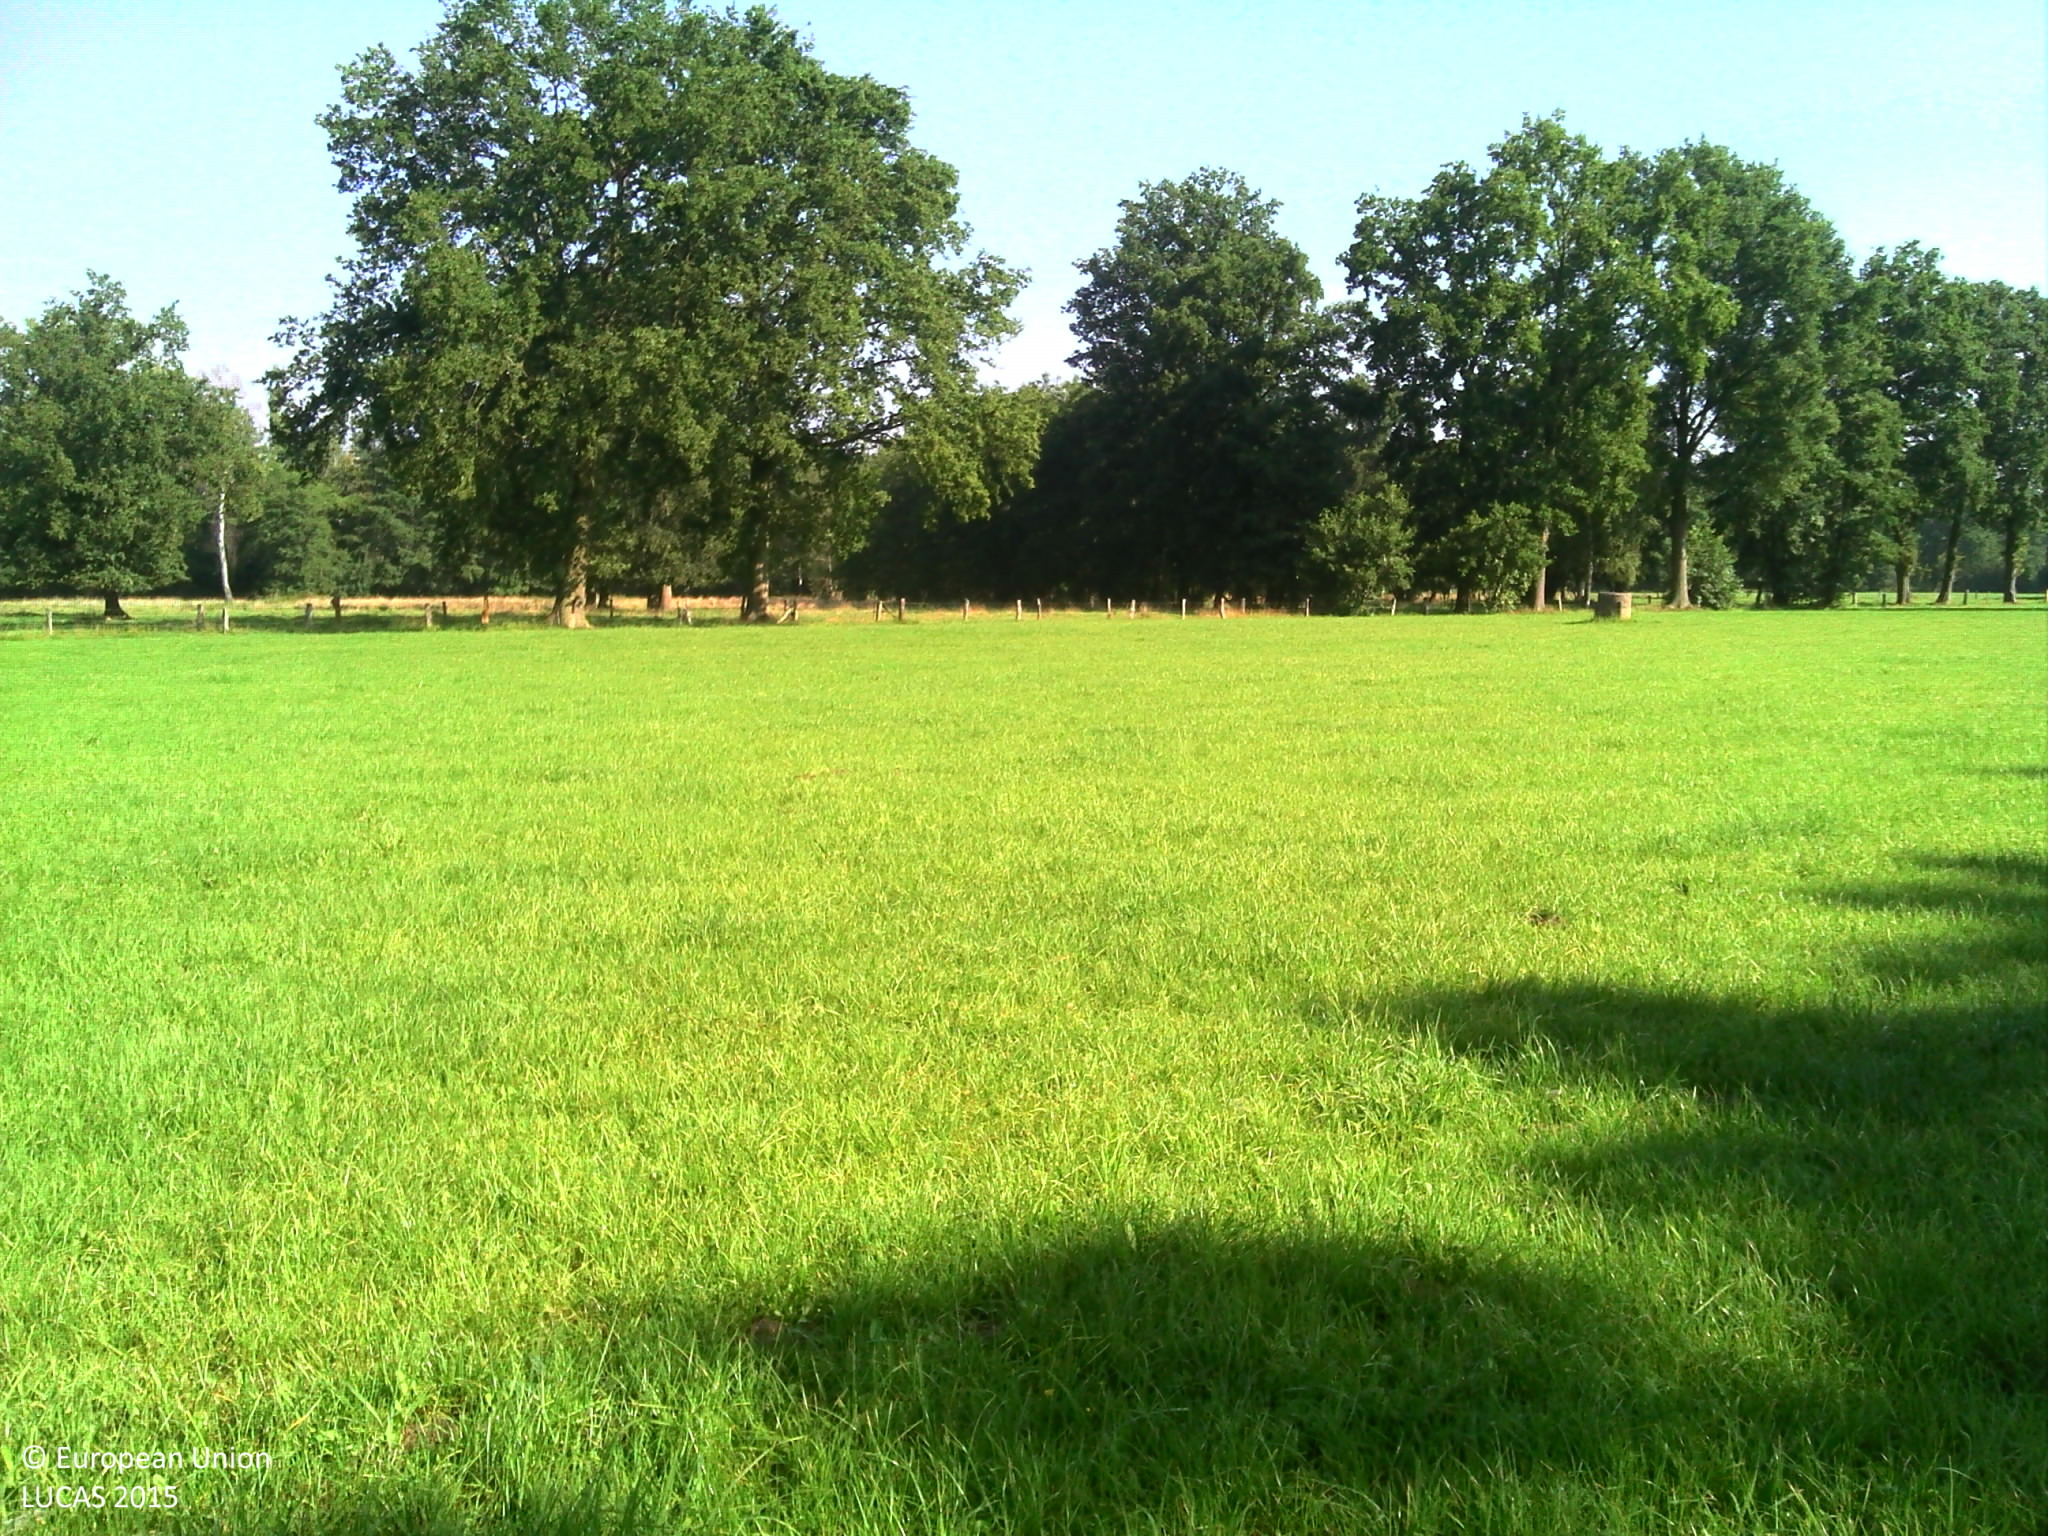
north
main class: Grassland
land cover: Grassland without tree/shrub cover
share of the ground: > 75 %
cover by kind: herbaceous plants 100 %
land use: Agriculture (excluding fallow land and kitchen gardens)
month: August
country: BE
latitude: 51.1654
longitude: 5.2355
